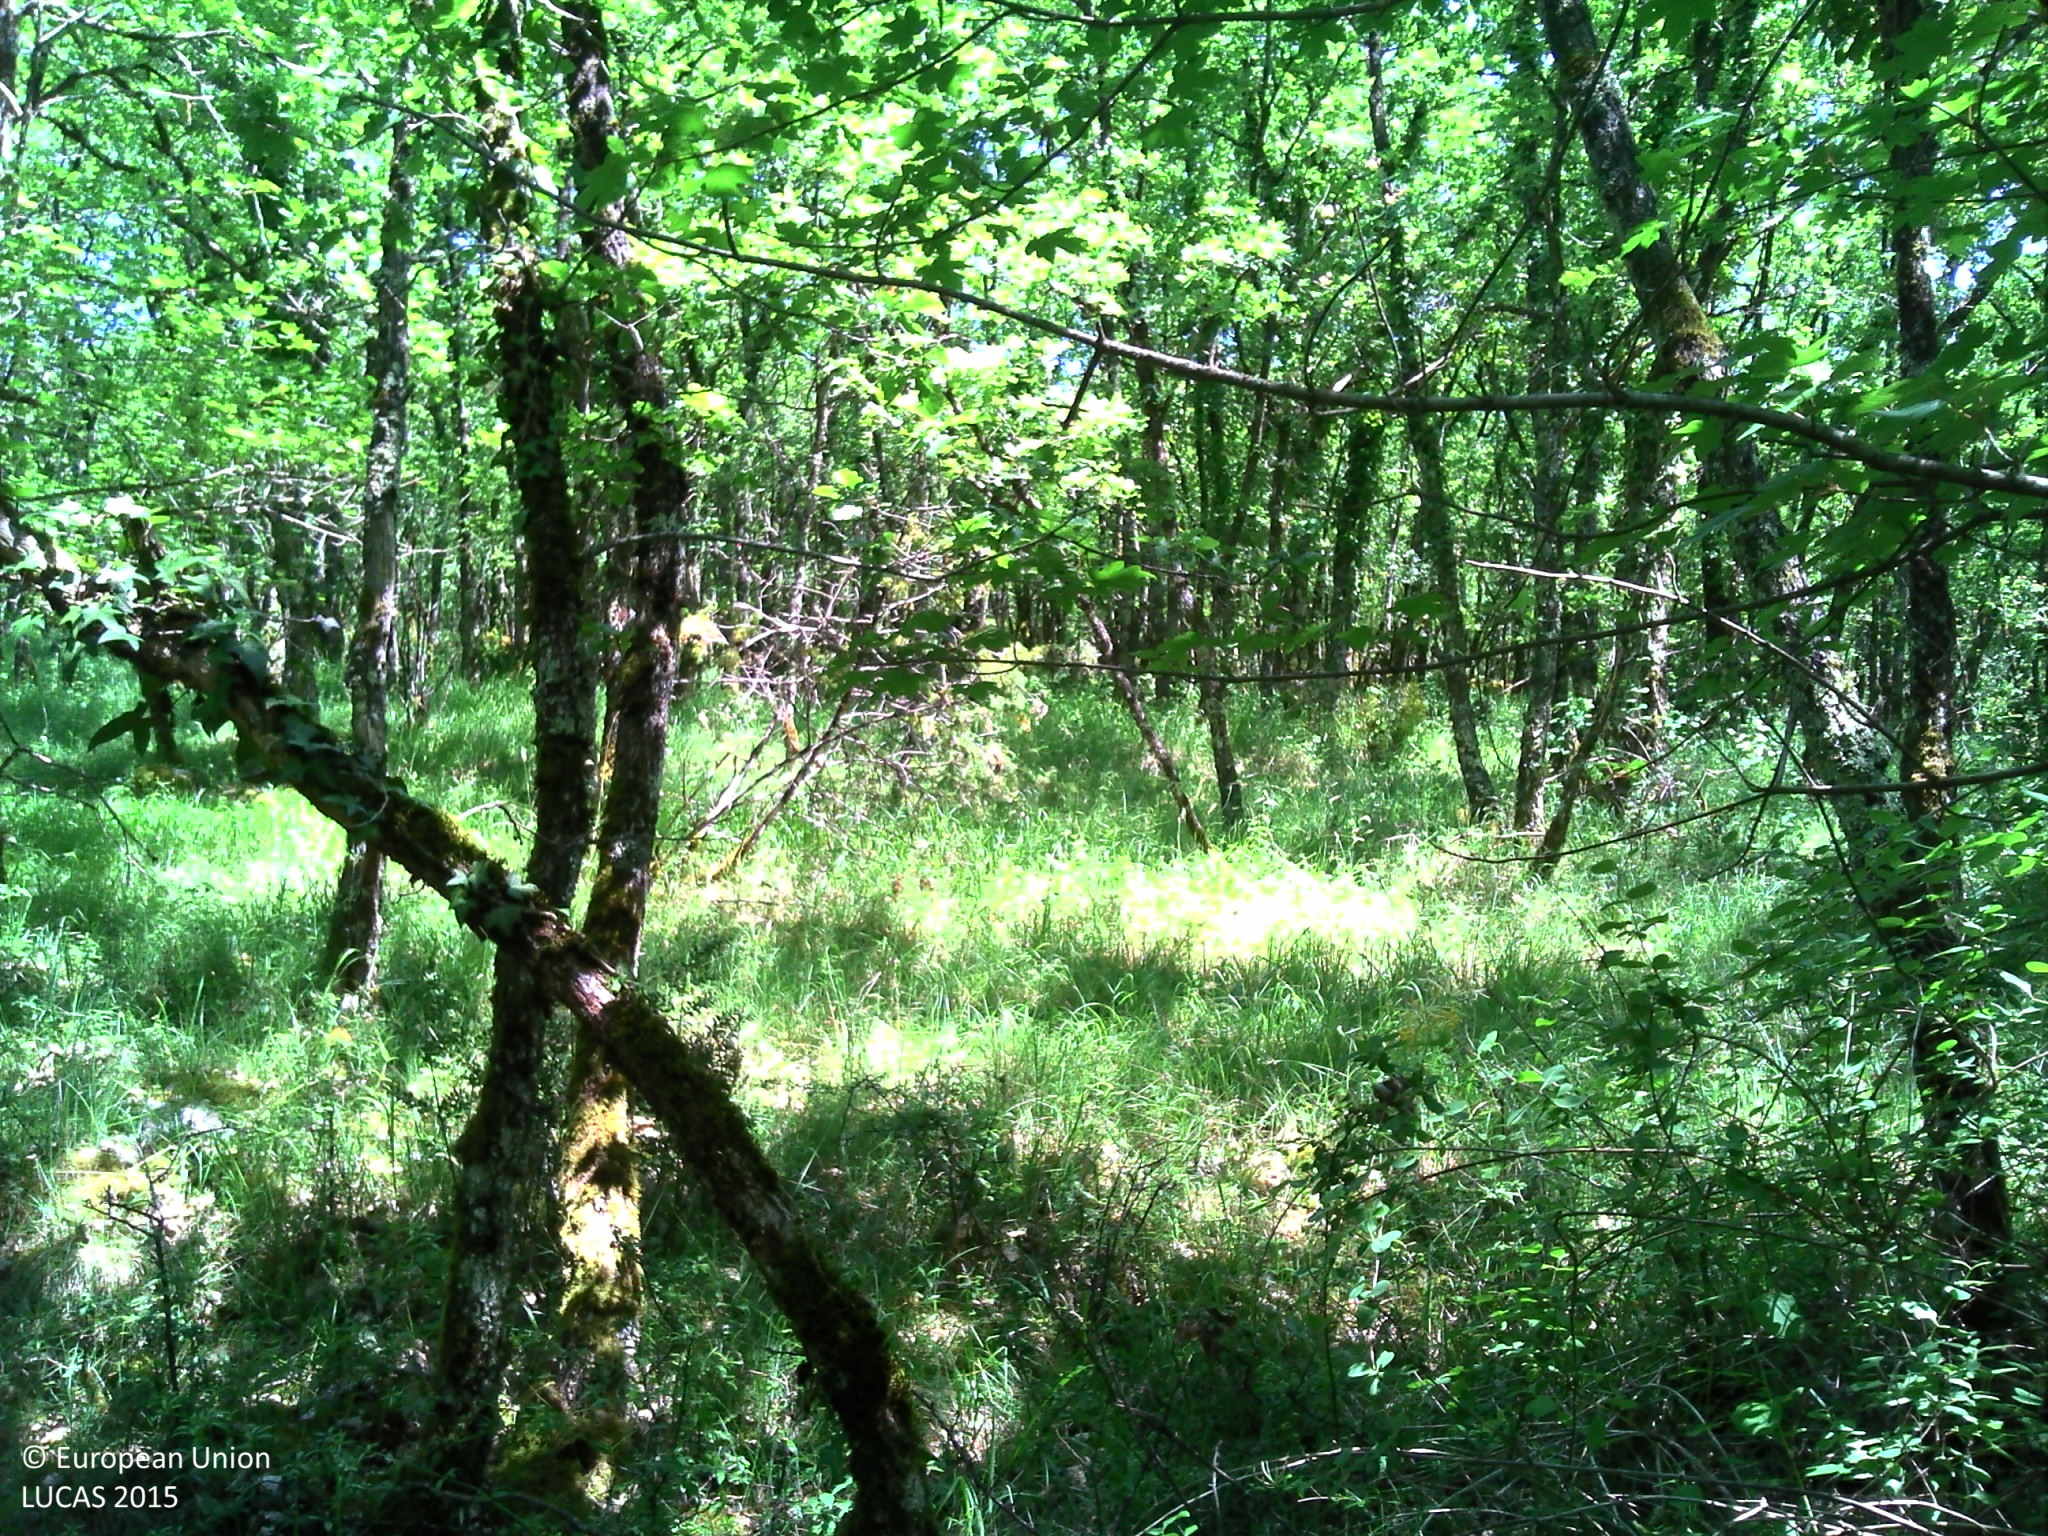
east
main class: Woodland
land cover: Broadleaved woodland
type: thermophilous deciduous forest
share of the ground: > 75 %
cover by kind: broadleaved forest trees 95 %, herbaceous plants 5 %
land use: Forestry
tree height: > 5 m
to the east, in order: Broadleaved woodland; Dry stone walls; Broadleaved woodland; Dry stone walls; Broadleaved woodland; Dry stone walls; Broadleaved woodland; Dry stone walls; Grass margins
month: May
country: FR
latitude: 44.5433
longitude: 1.9322
